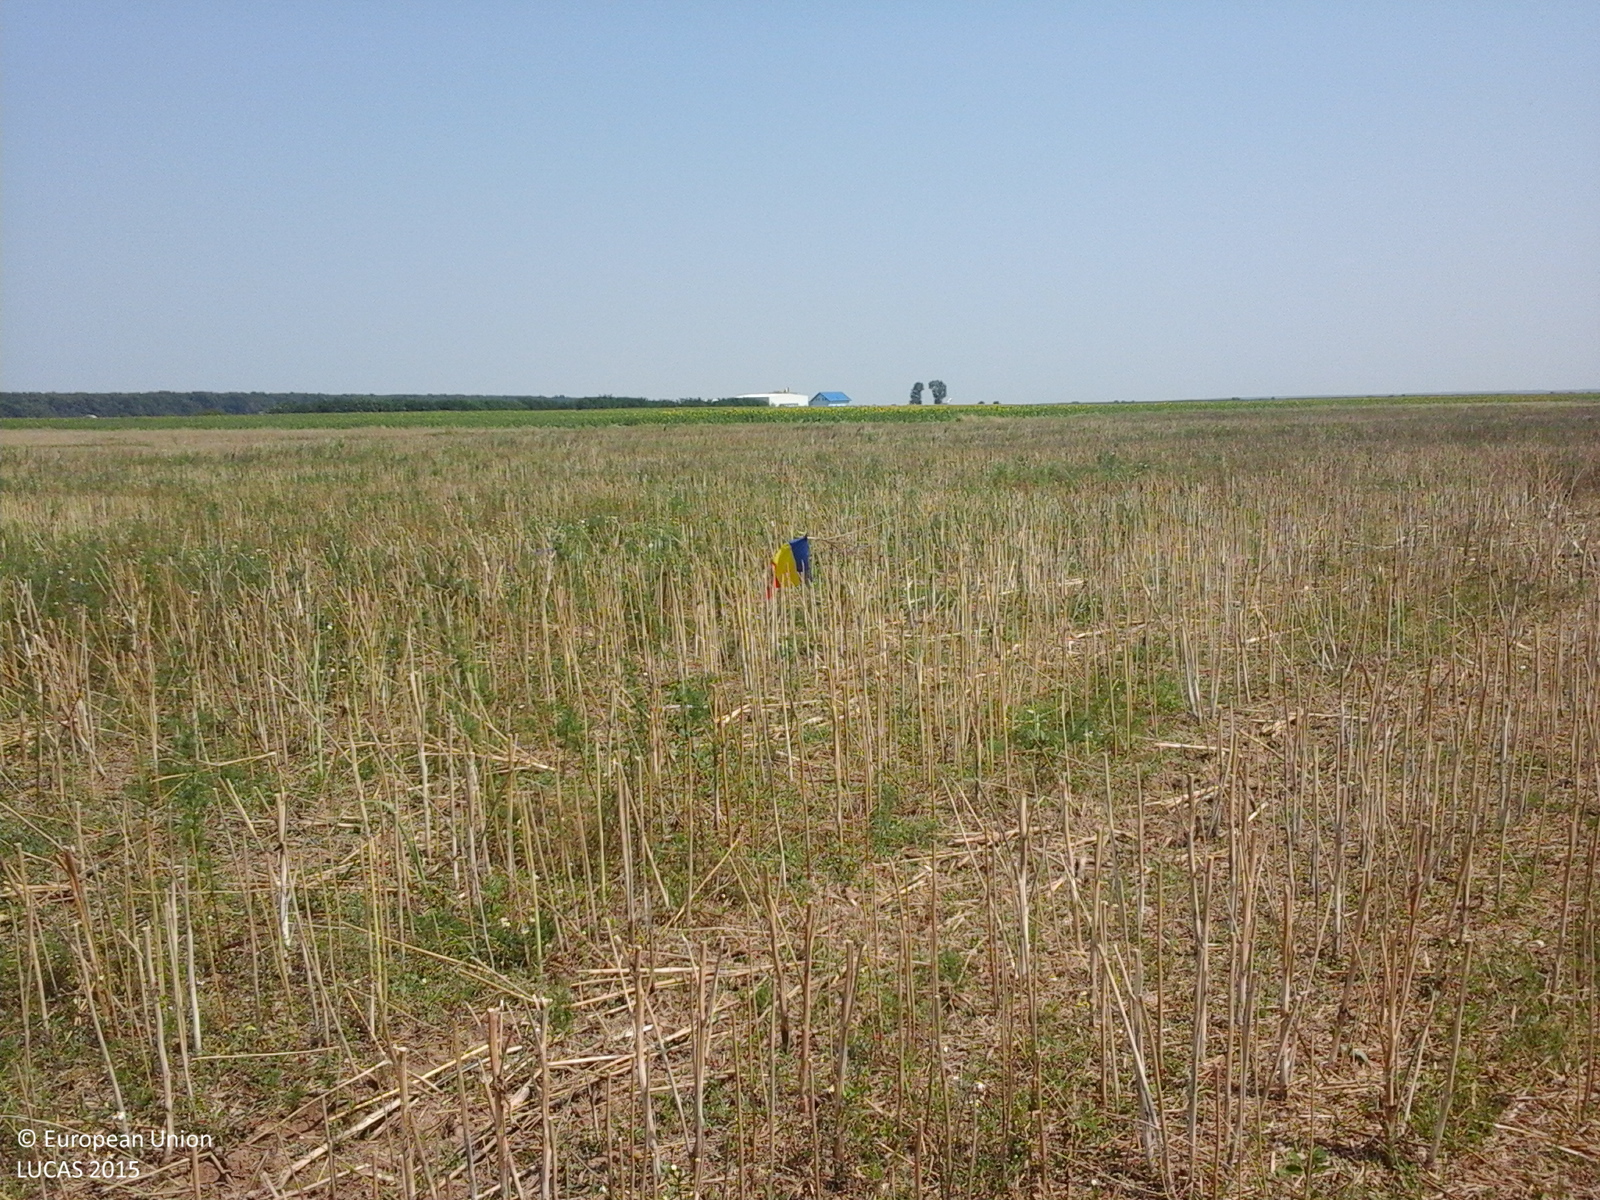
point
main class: Cropland
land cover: Rape and turnip rape
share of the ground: < 10 %
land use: Agriculture (excluding fallow land and kitchen gardens)
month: July
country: RO
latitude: 44.7971
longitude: 25.5821
